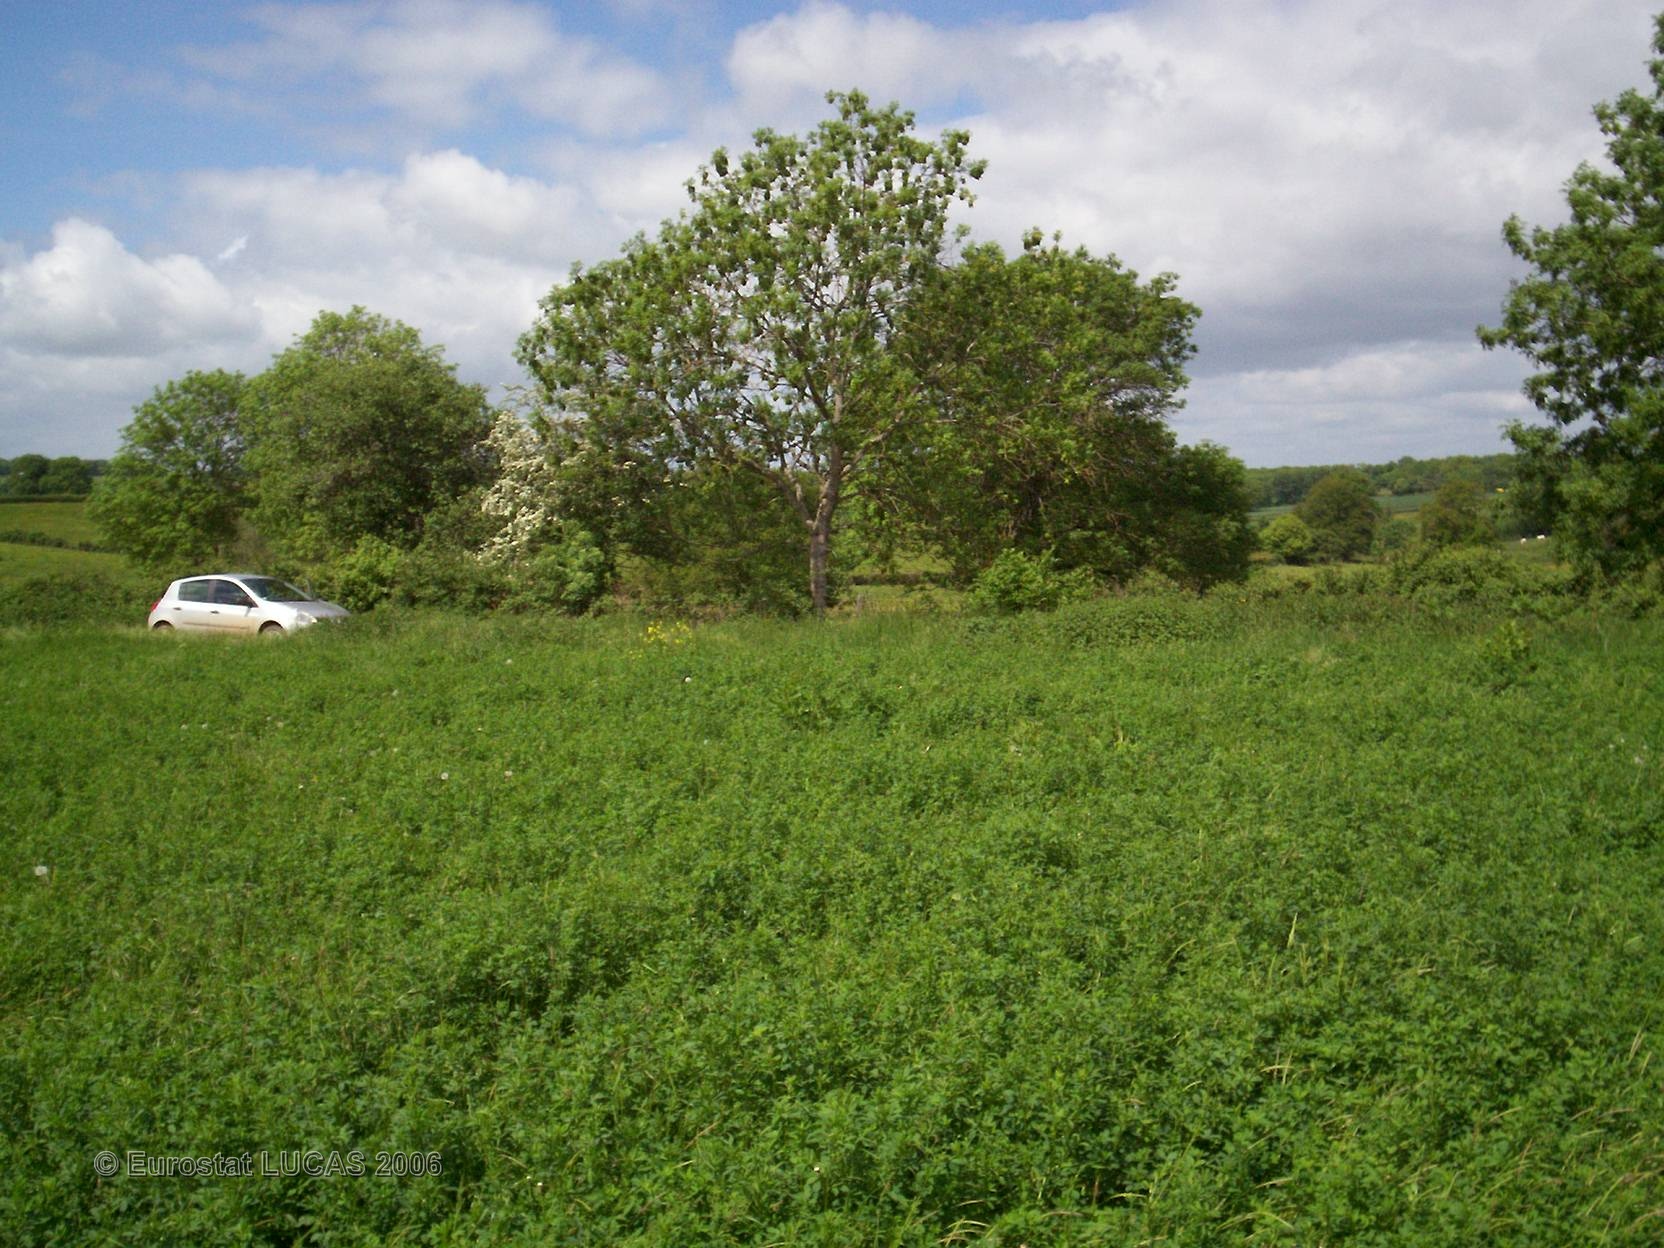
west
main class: Cropland
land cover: Lucerne
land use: Agriculture (excluding fallow land and kitchen gardens)
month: May
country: FR
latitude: 47.0471
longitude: 4.6431
